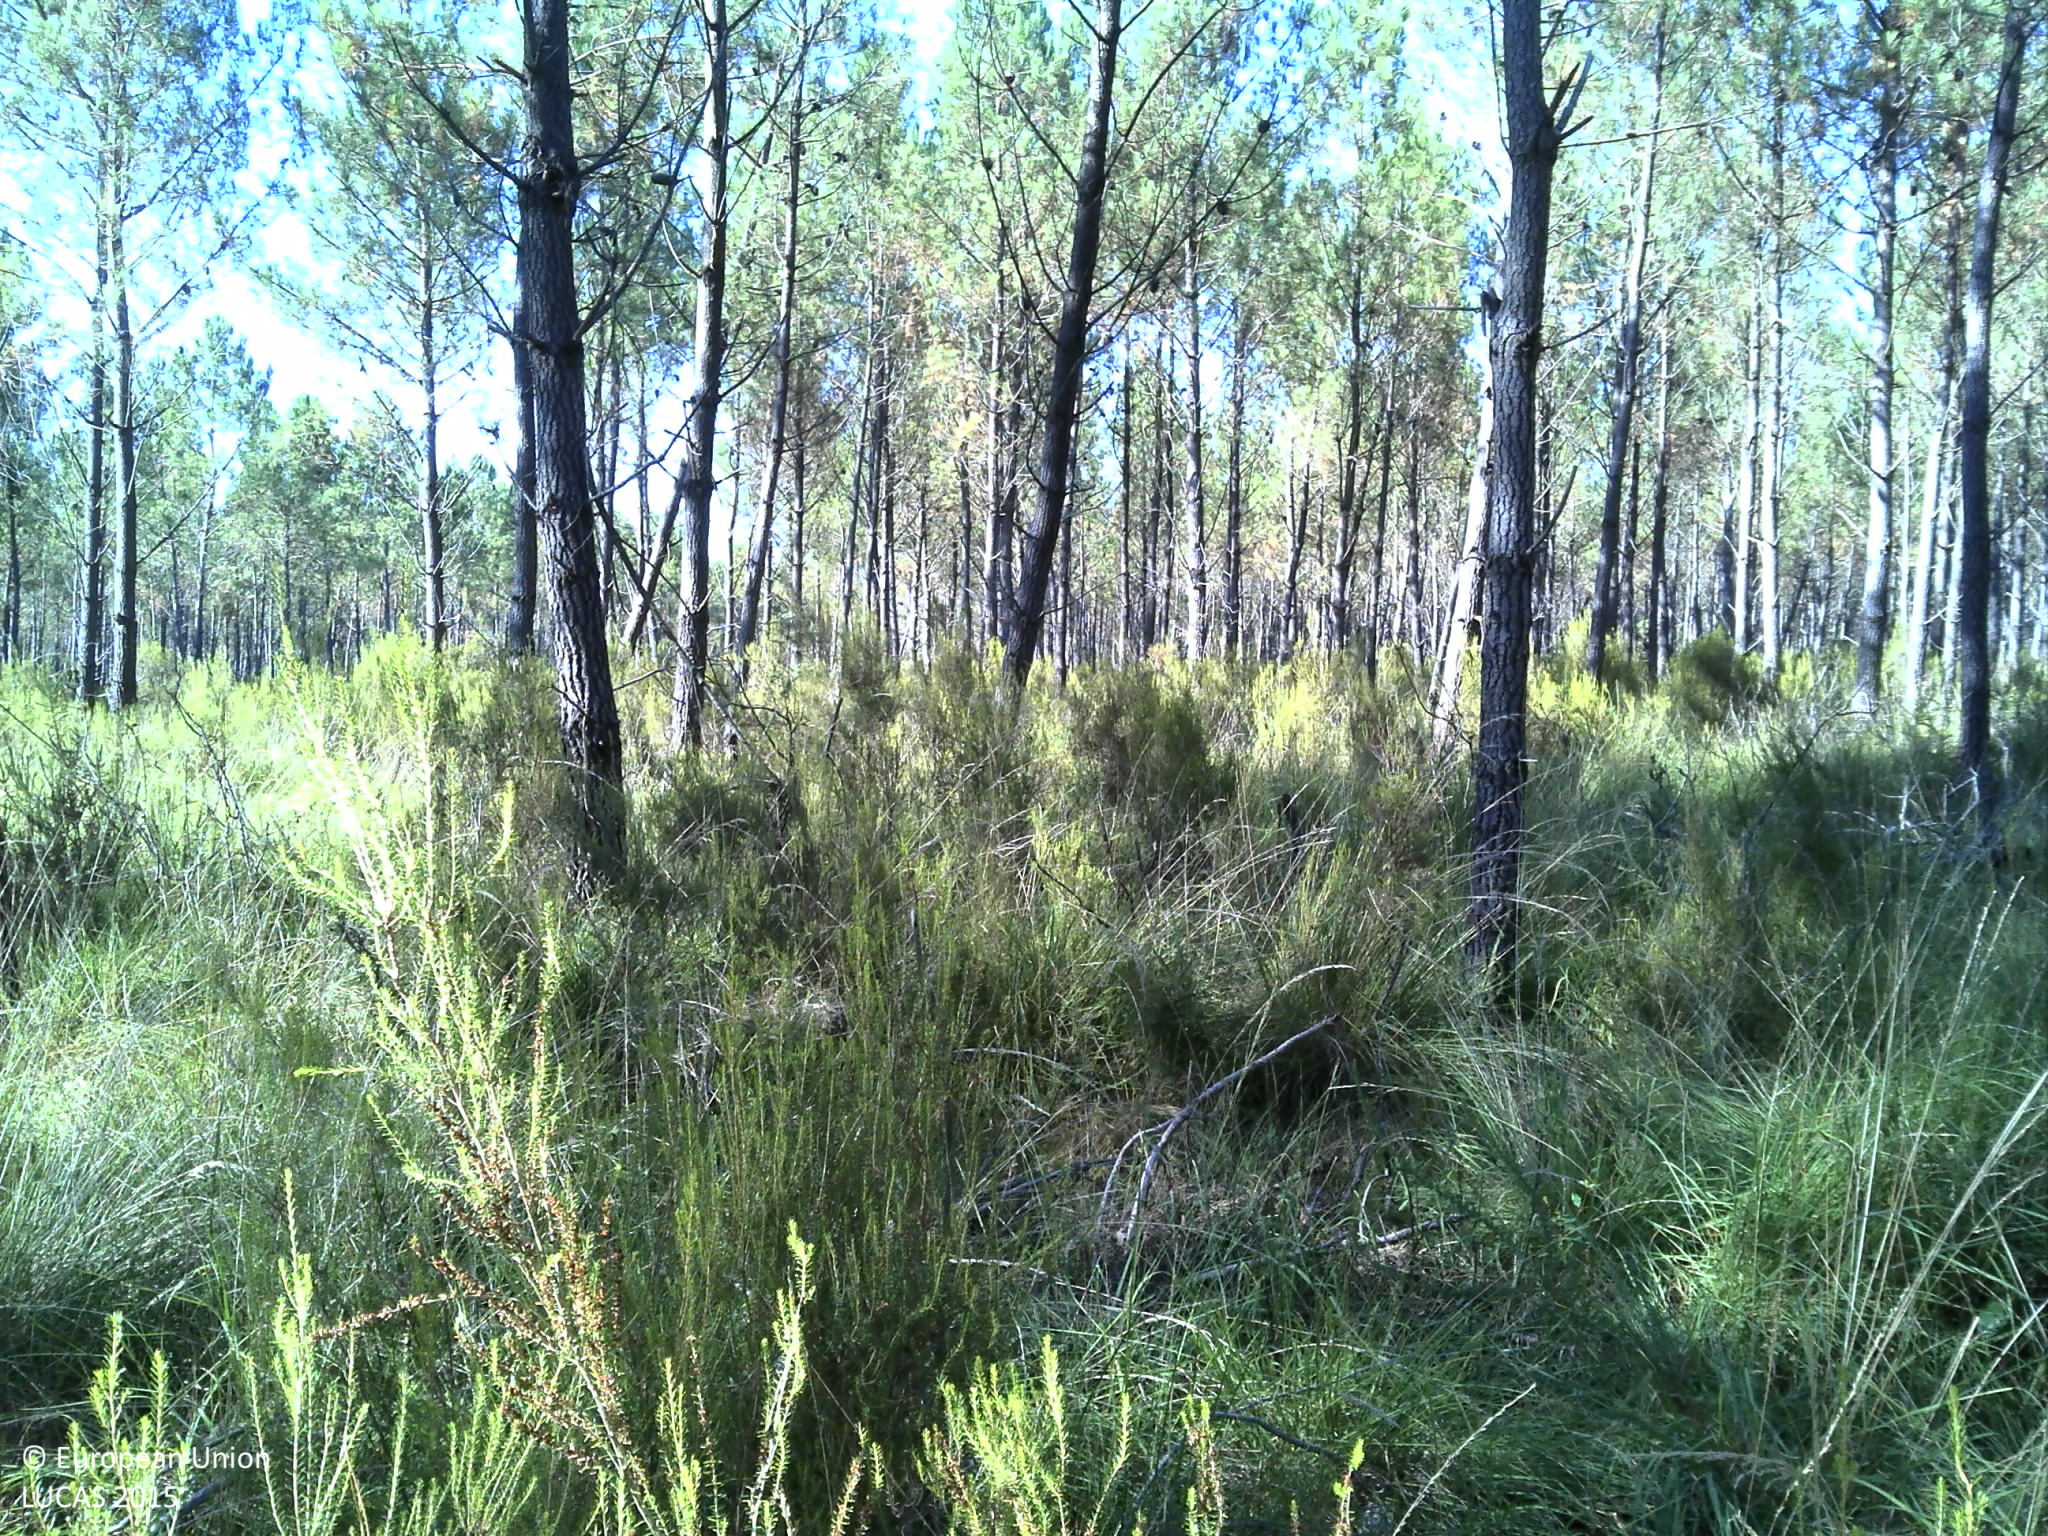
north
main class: Woodland
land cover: Pine dominated coniferous woodland
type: coniferous forest of the mediterranean region
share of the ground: > 75 %
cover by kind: herbaceous plants 50 %, coniferous forest trees 30 %, shrubs 20 %
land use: Forestry
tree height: > 5 m
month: August
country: FR
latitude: 45.2269
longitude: -1.0938
